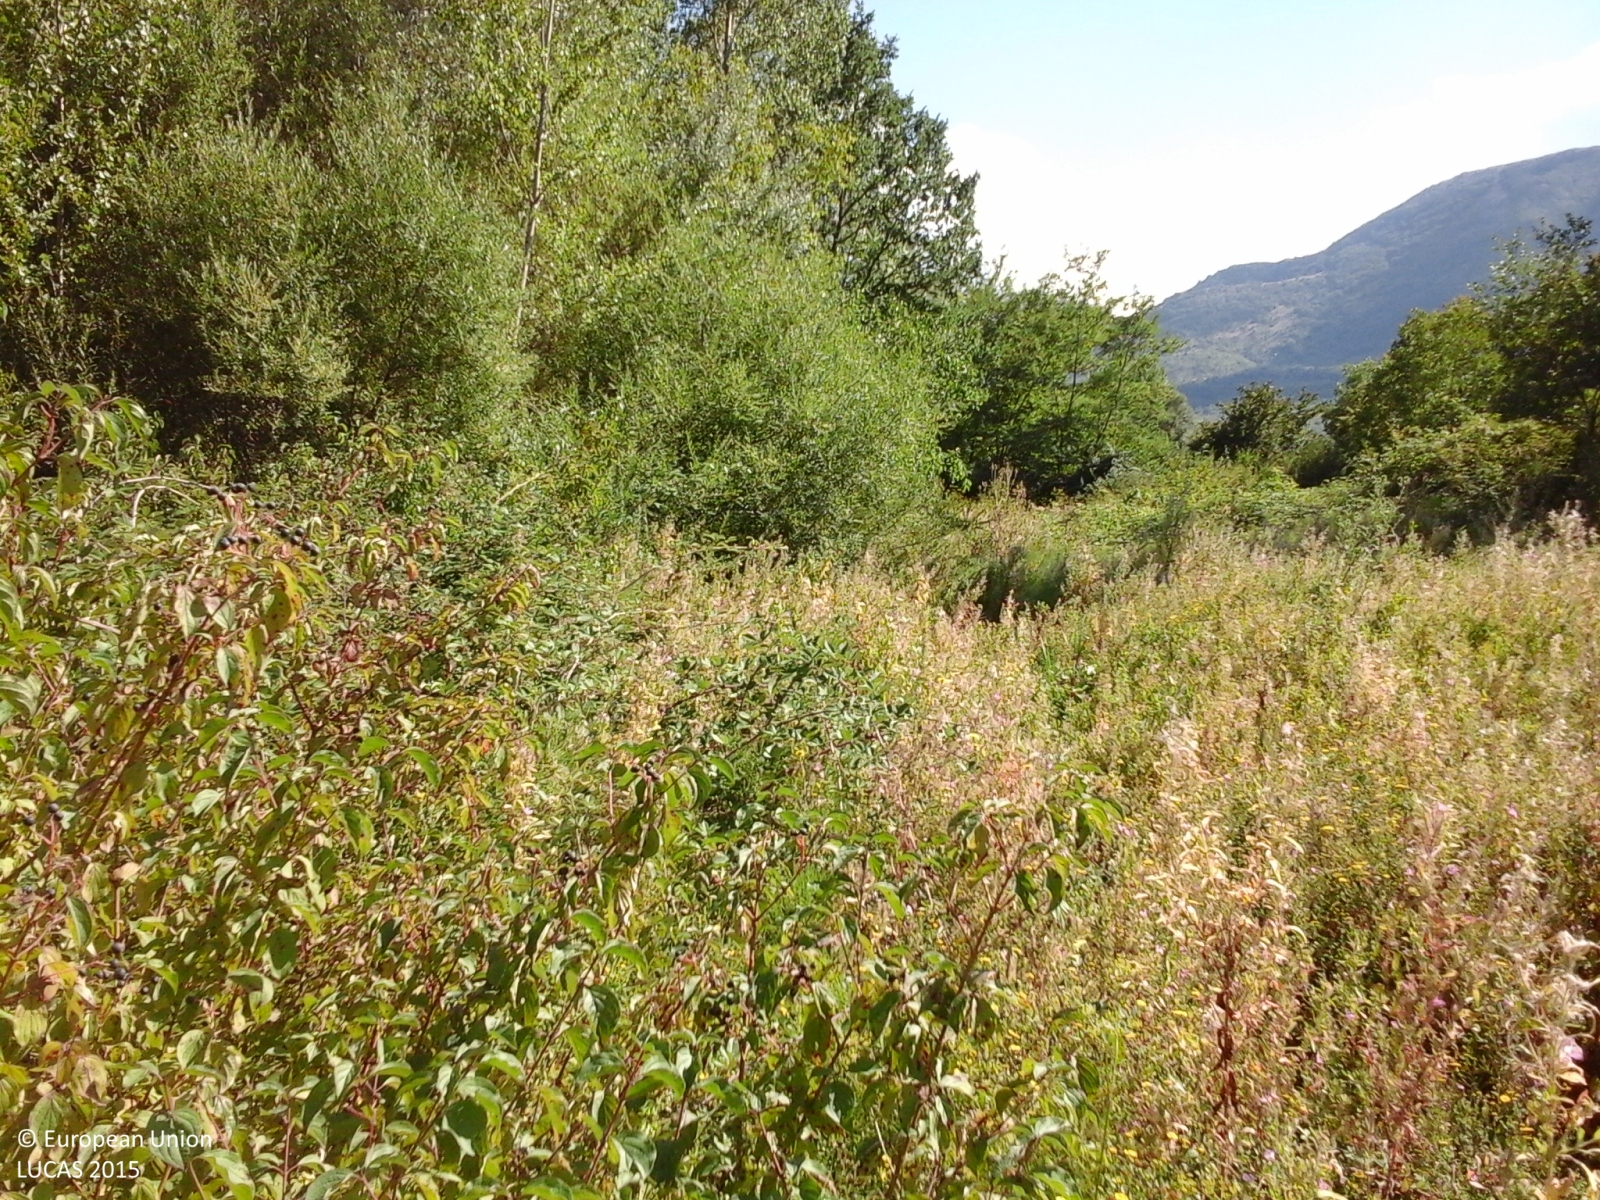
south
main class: Grassland
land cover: Spontaneously vegetated surfaces
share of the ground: > 75 %
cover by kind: herbaceous plants 100 %
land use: Fallow land
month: August
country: IT
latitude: 41.5470
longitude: 14.3600
